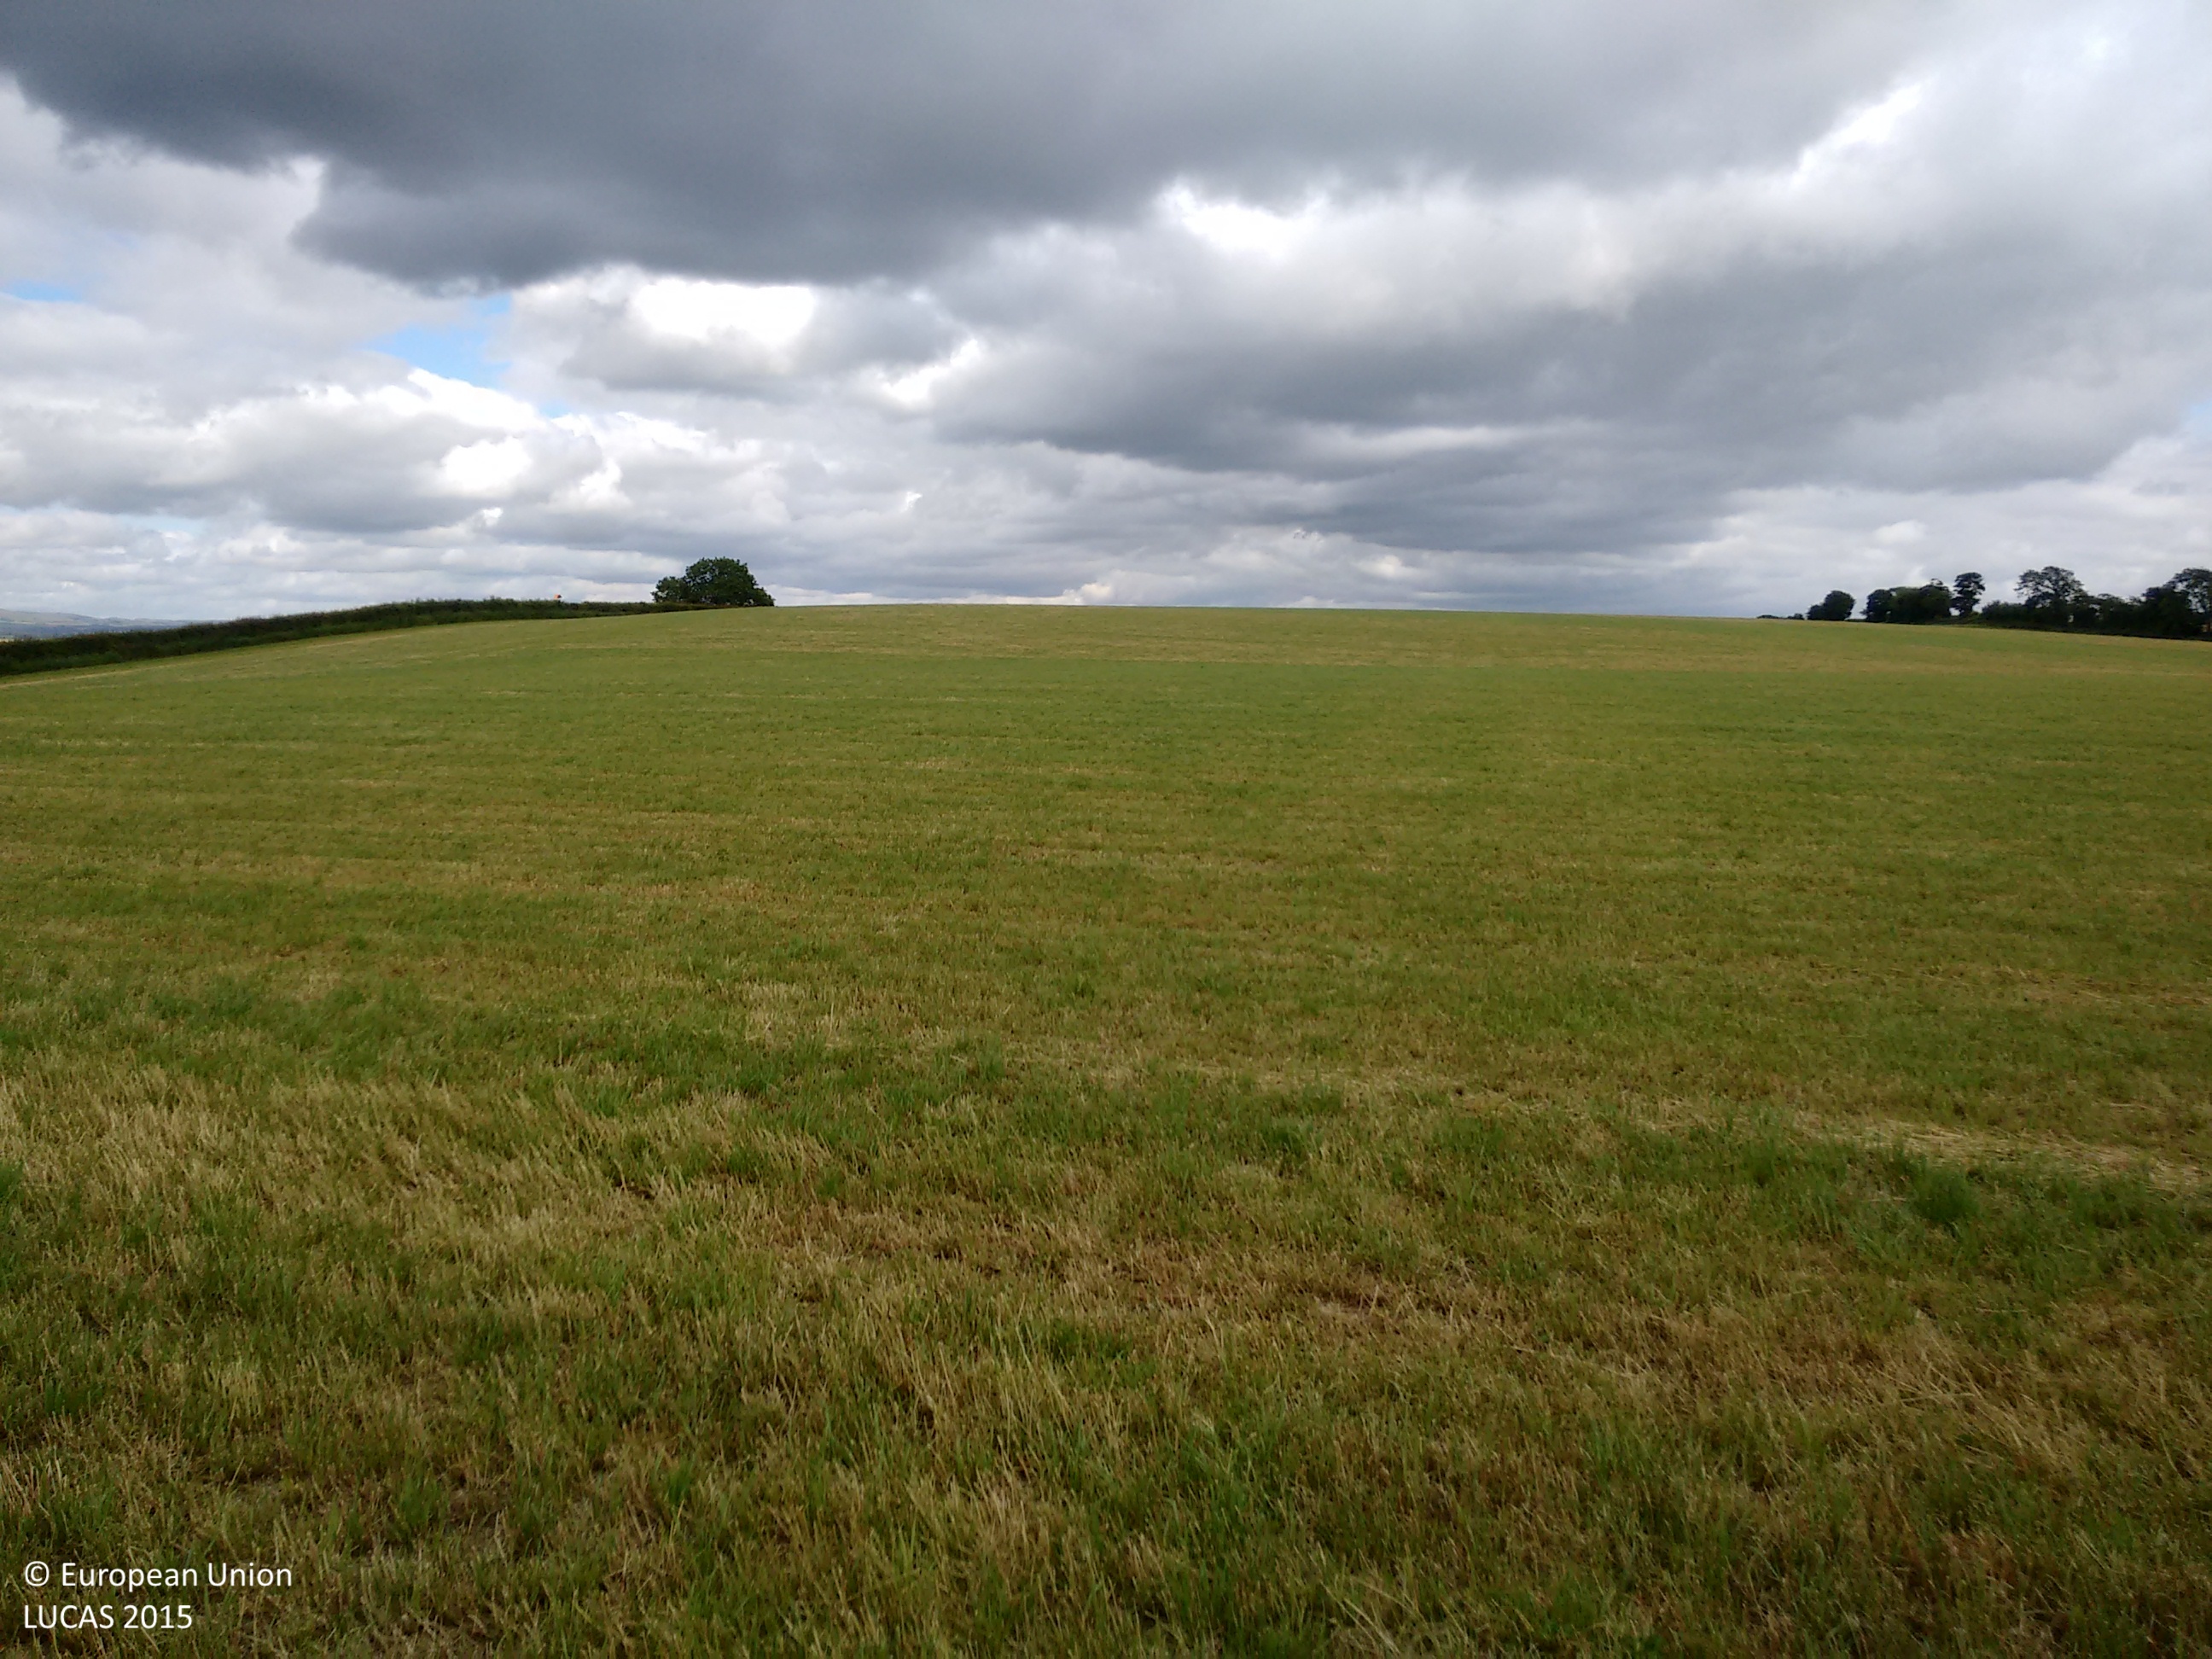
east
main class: Grassland
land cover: Grassland without tree/shrub cover
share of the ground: > 75 %
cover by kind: herbaceous plants 100 %
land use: Agriculture (excluding fallow land and kitchen gardens)
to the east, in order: Grassland without tree/shrub cover
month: June
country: GB
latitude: 56.0004
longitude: -3.6619
